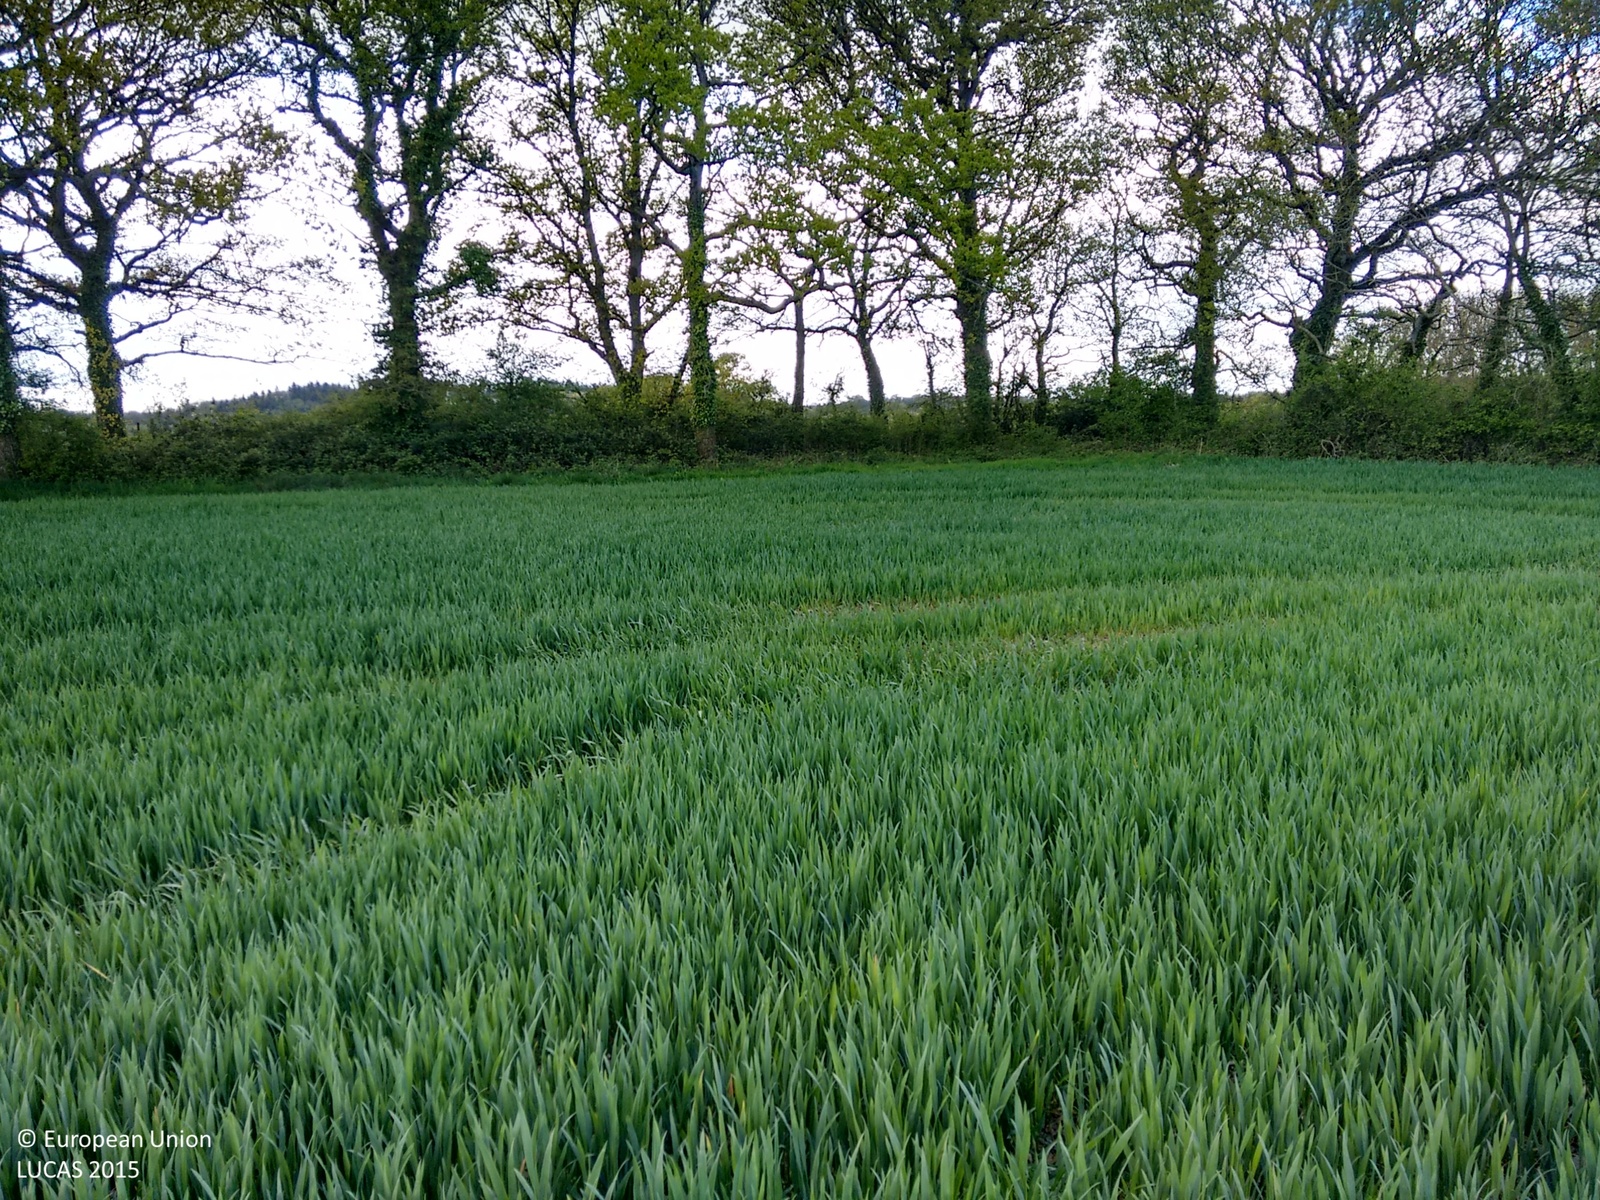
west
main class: Cropland
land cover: Common wheat
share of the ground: > 75 %
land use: Agriculture (excluding fallow land and kitchen gardens)
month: April
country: GB
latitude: 50.9241
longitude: -1.8786
